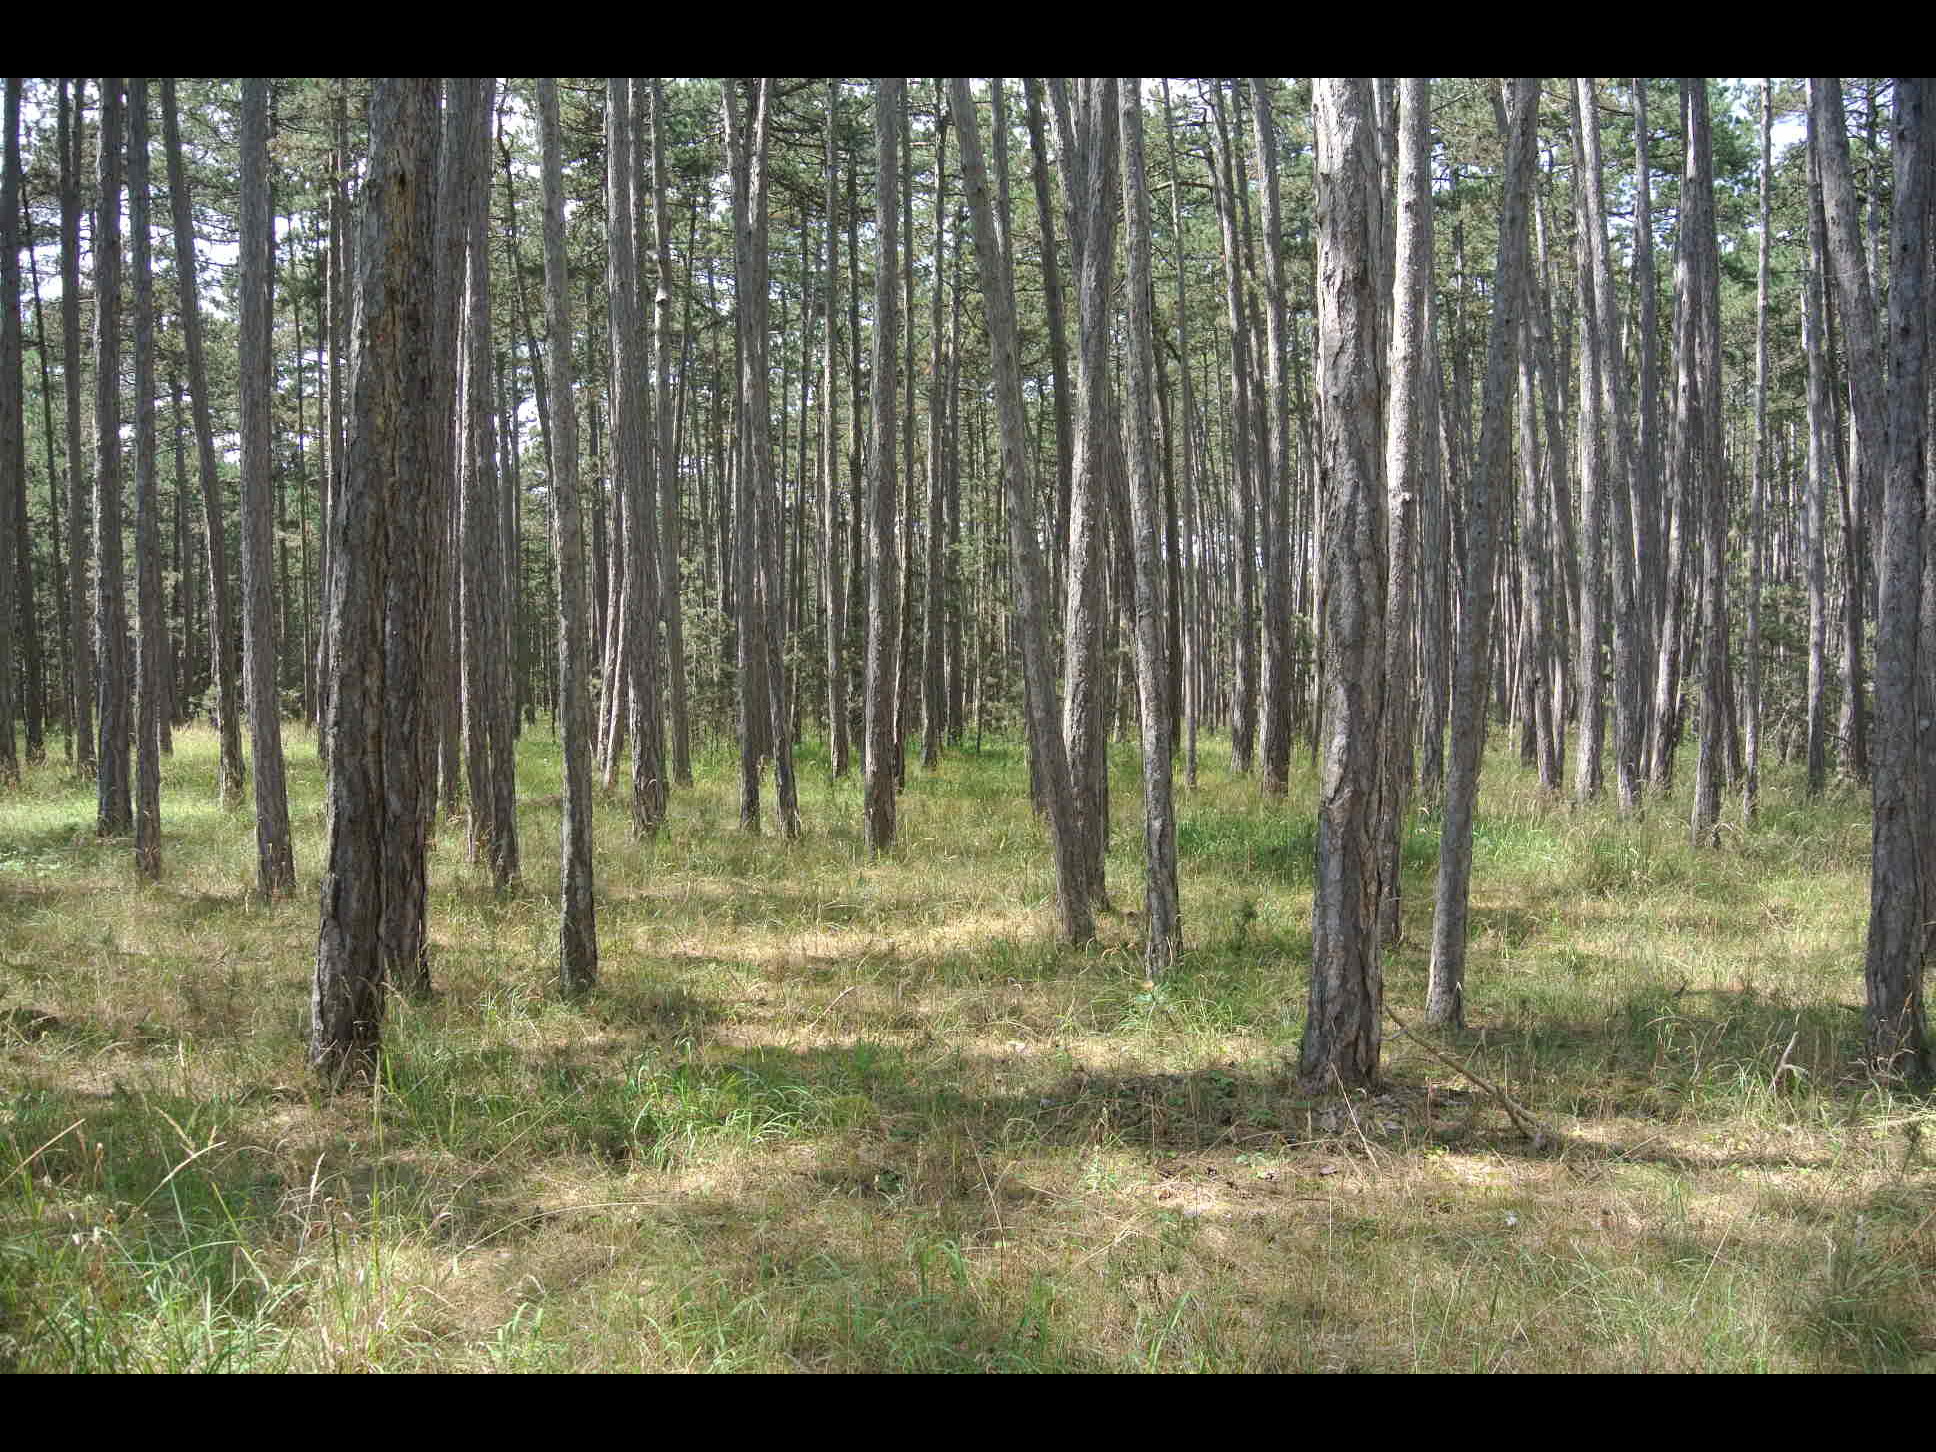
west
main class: Woodland
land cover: Pine dominated coniferous woodland
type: alpine coniferous forest
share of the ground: > 75 %
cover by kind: coniferous forest trees 100 %
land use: Forestry
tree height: > 5 m
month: July
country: AT
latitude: 47.7464
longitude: 16.1251
